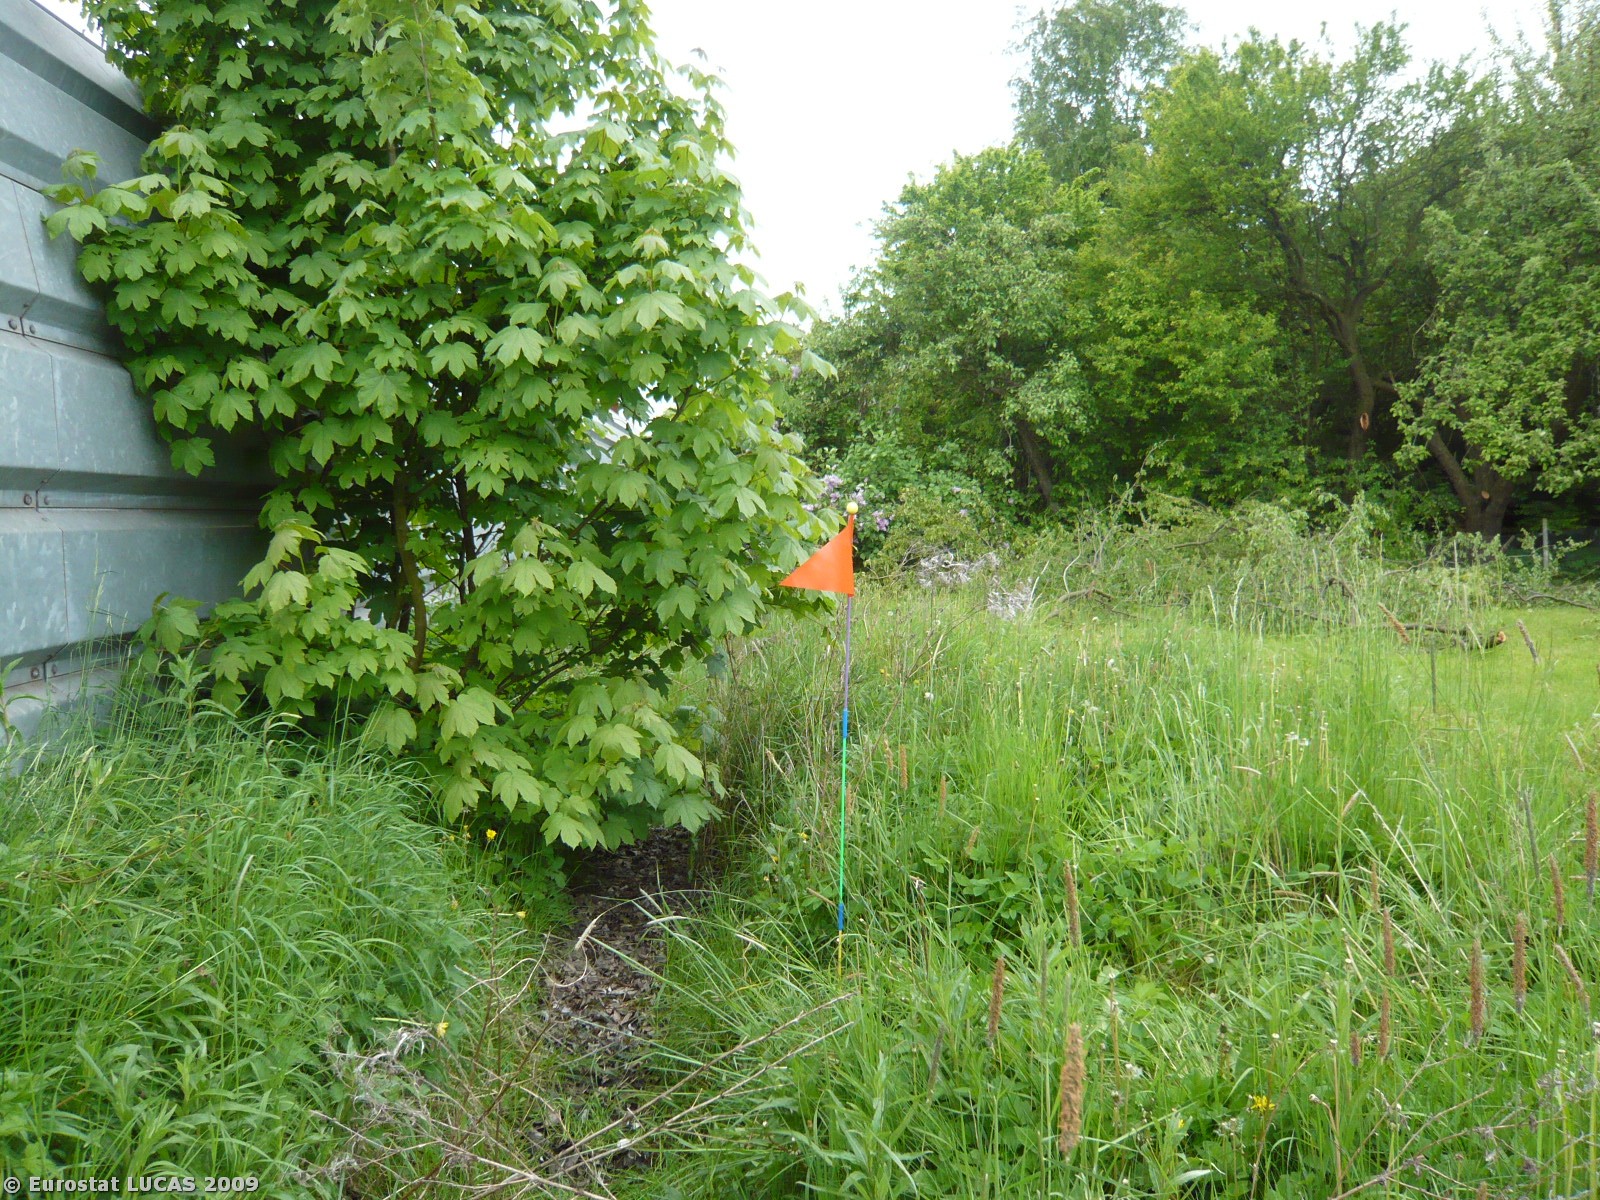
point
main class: Grassland
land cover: Grassland without tree/shrub cover
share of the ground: > 75 %
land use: Residential
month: May
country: DK
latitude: 55.4399
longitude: 11.6583
